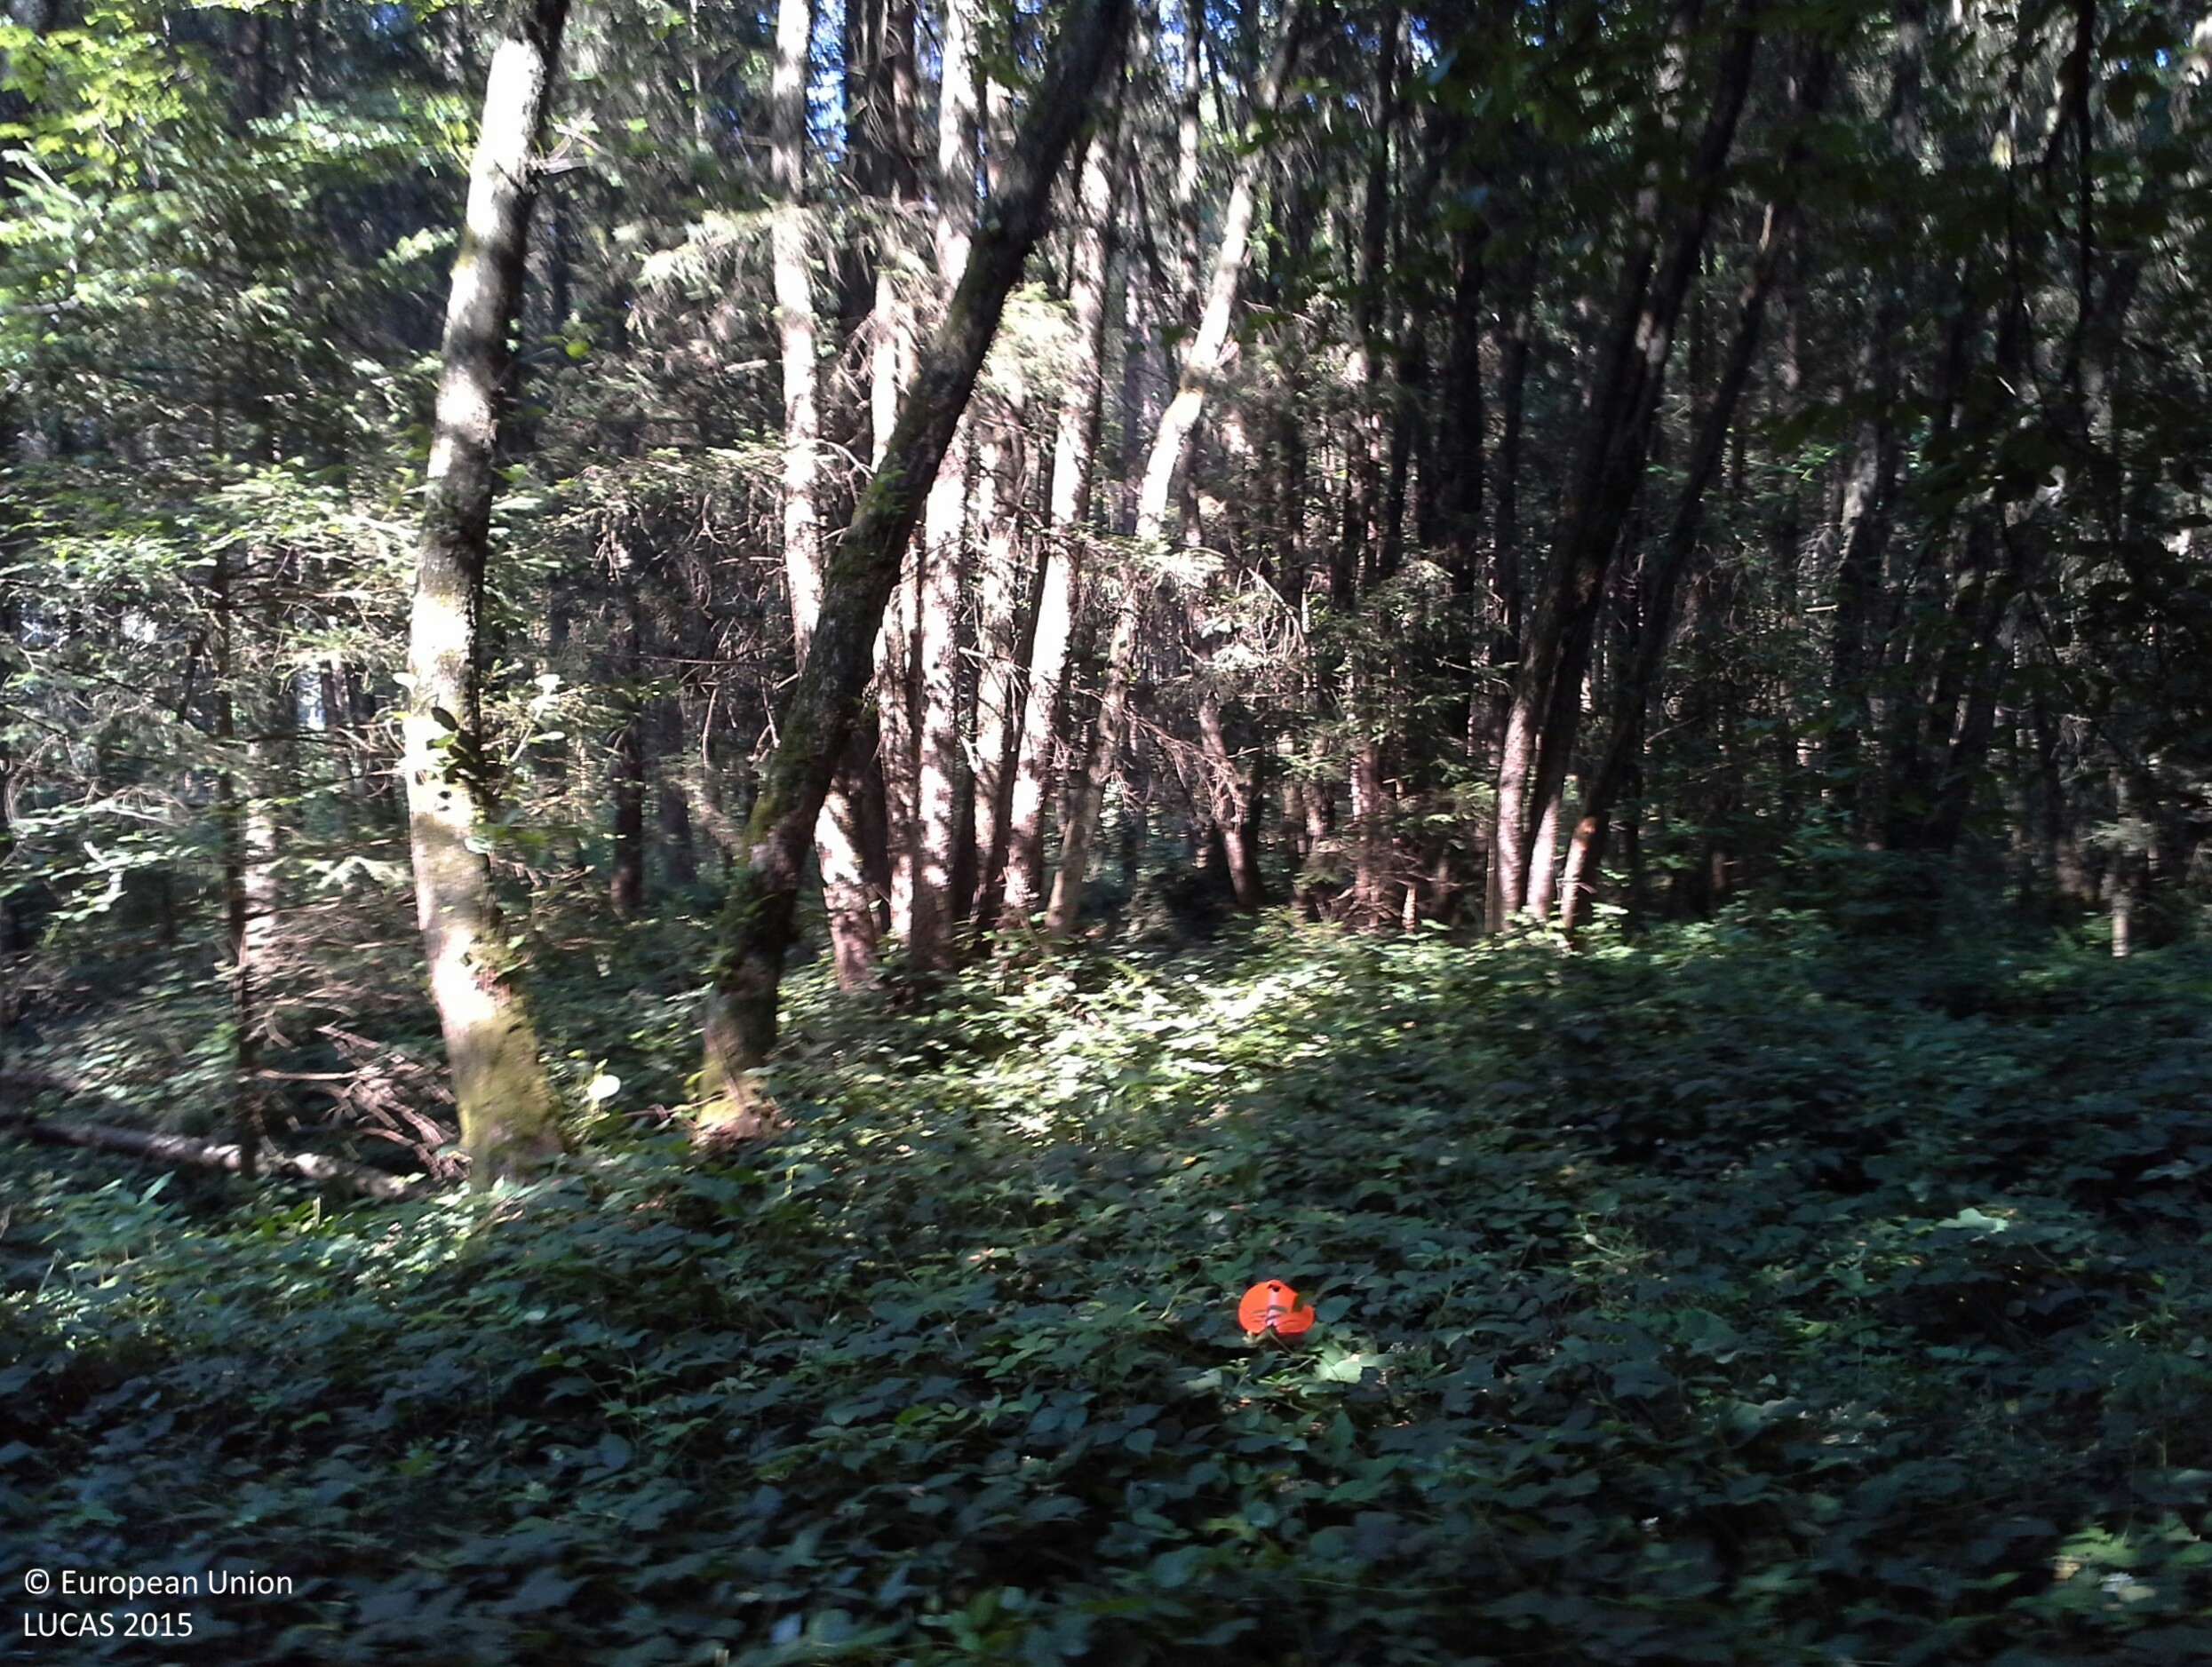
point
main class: Woodland
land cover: Spruce dominated mixed woodland
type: mesophytic deciduous forest
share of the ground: > 75 %
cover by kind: coniferous forest trees 60 %, broadleaved forest trees 25 %, herbaceous plants 10 %, shrubs 5 %
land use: Forestry
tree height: > 5 m
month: July
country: AT
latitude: 48.1468
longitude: 14.9876
